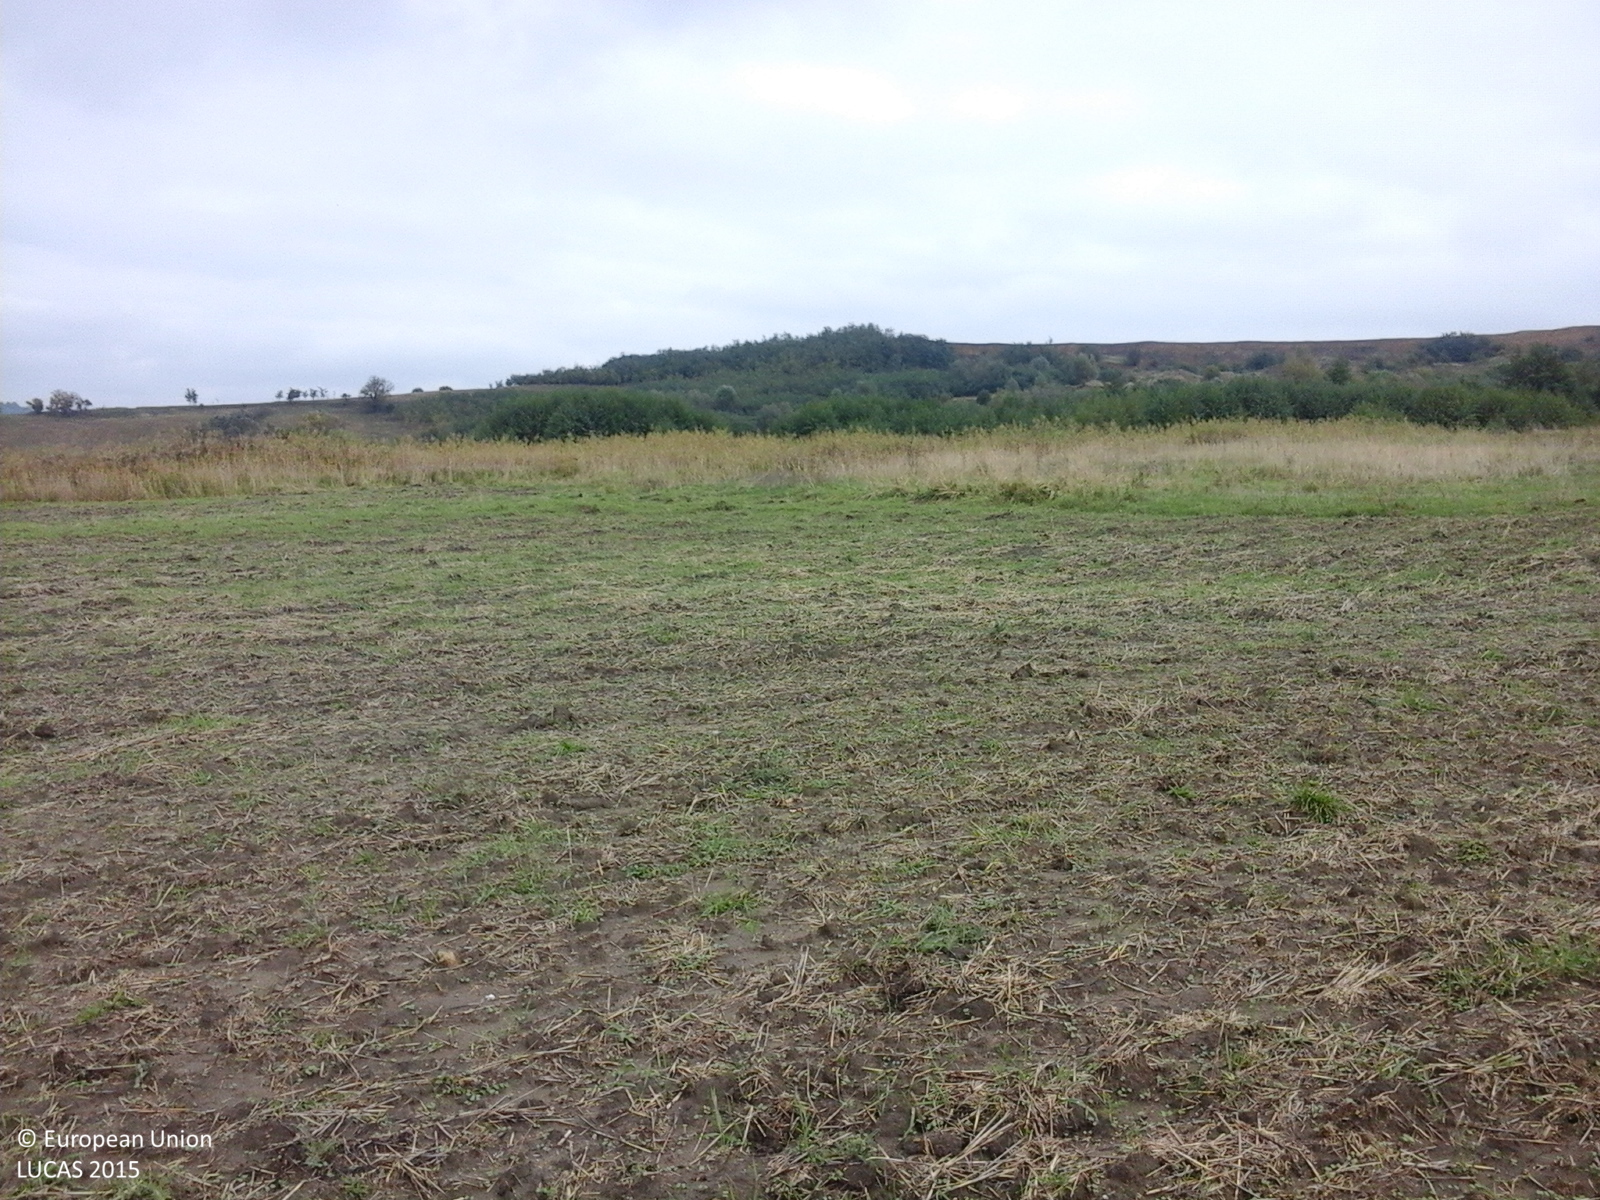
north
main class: Cropland
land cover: Rape and turnip rape
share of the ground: < 10 %
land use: Agriculture (excluding fallow land and kitchen gardens)
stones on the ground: < 10 %
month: October
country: RO
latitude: 46.1013
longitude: 24.2702
